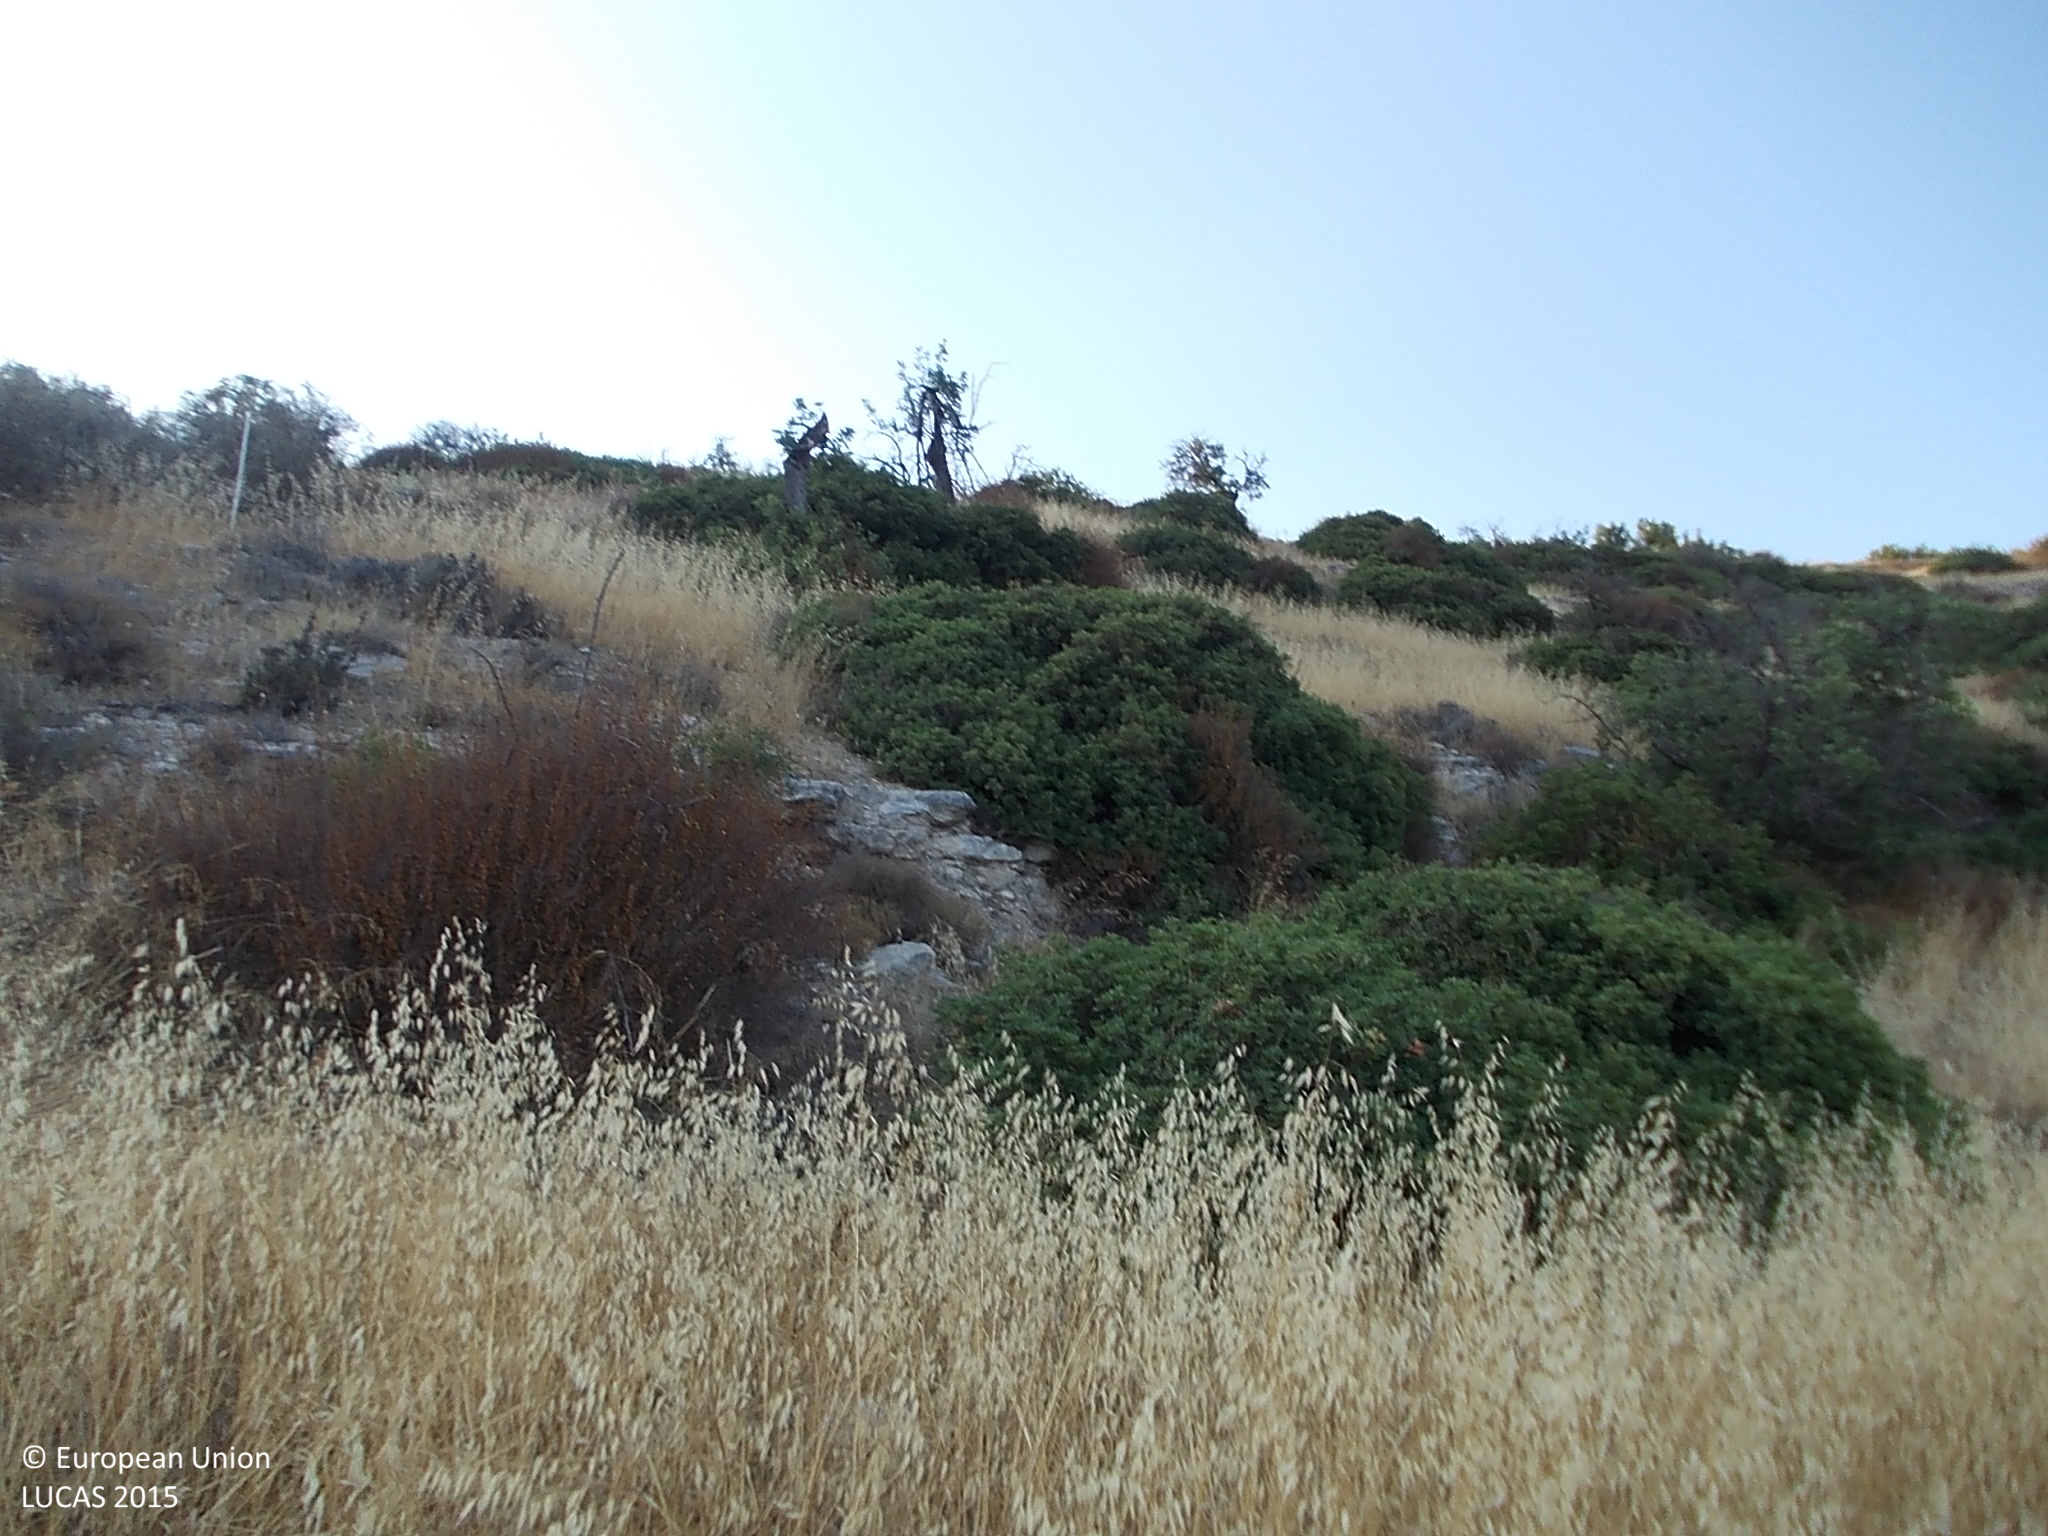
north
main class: Shrubland
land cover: Shrubland with sparse tree cover
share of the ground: > 75 %
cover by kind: shrubs 75 %, herbaceous plants 15 %, broadleaved forest trees 5 %, consolidated bare surface 5 %
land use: Semi-natural and natural areas not in use
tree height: < 5 m
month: August
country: CY
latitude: 34.7716
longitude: 33.0140
